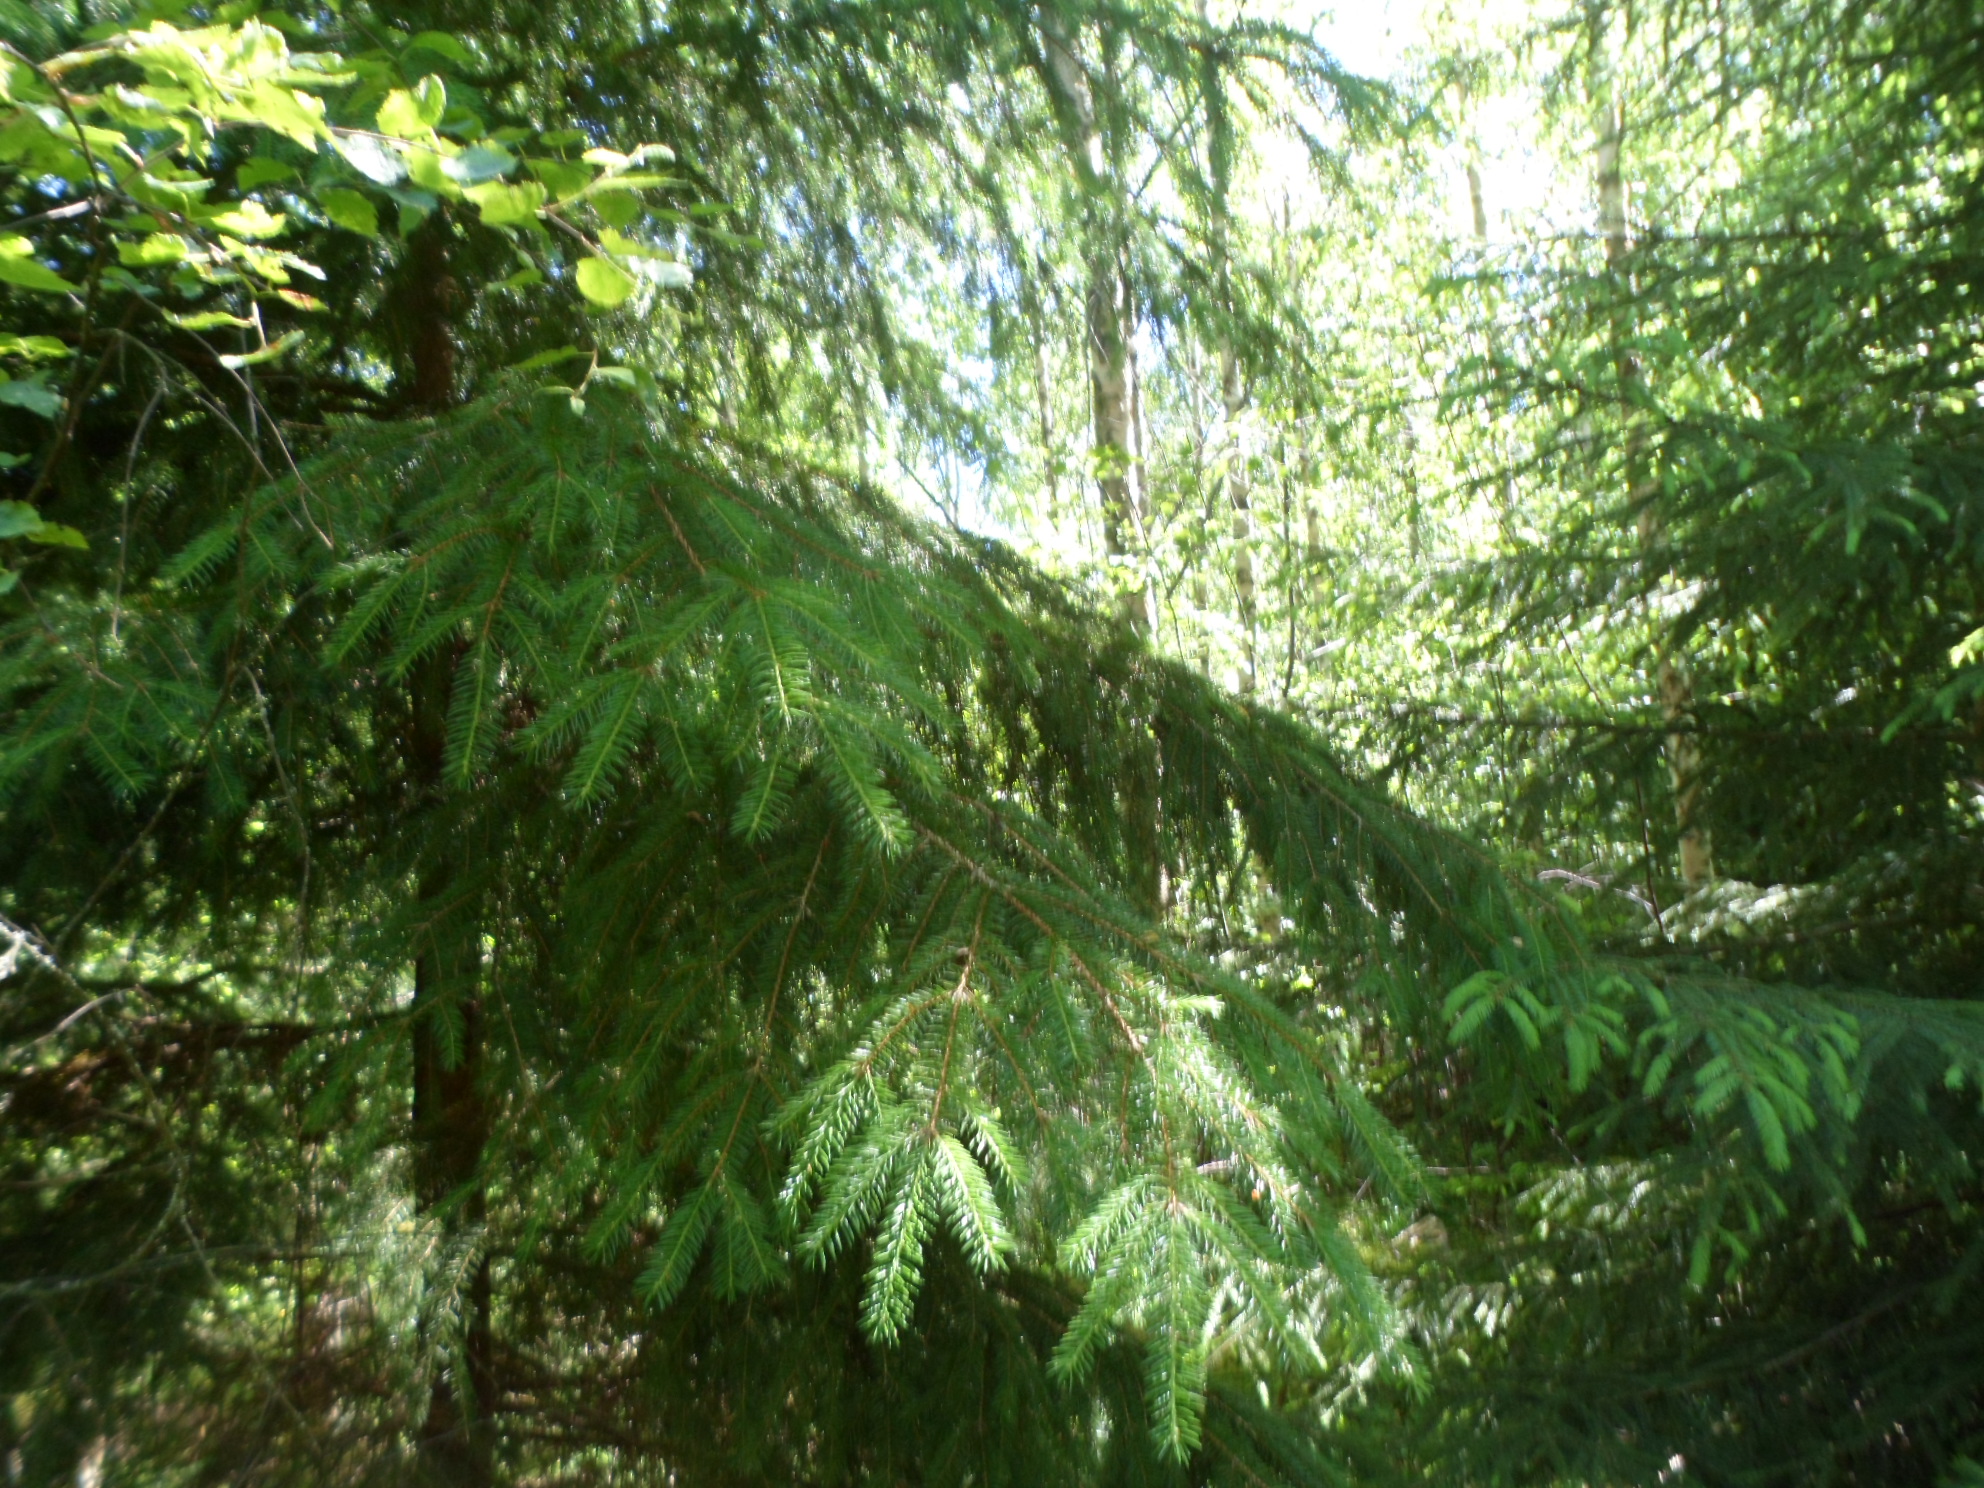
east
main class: Woodland
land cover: Spruce dominated mixed woodland
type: boreal forest
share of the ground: 50 - 75 %
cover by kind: coniferous forest trees 35 %, broadleaved forest trees 35 %, herbaceous plants 20 %, shrubs 5 %, lichens and mosses 5 %
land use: Forestry
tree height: > 5 m
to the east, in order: Spruce dominated mixed woodland; Spruce dominated coniferous woodland; Broadleaved woodland; Spruce dominated mixed woodland
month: July
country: SE
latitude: 57.1161
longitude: 14.5378
